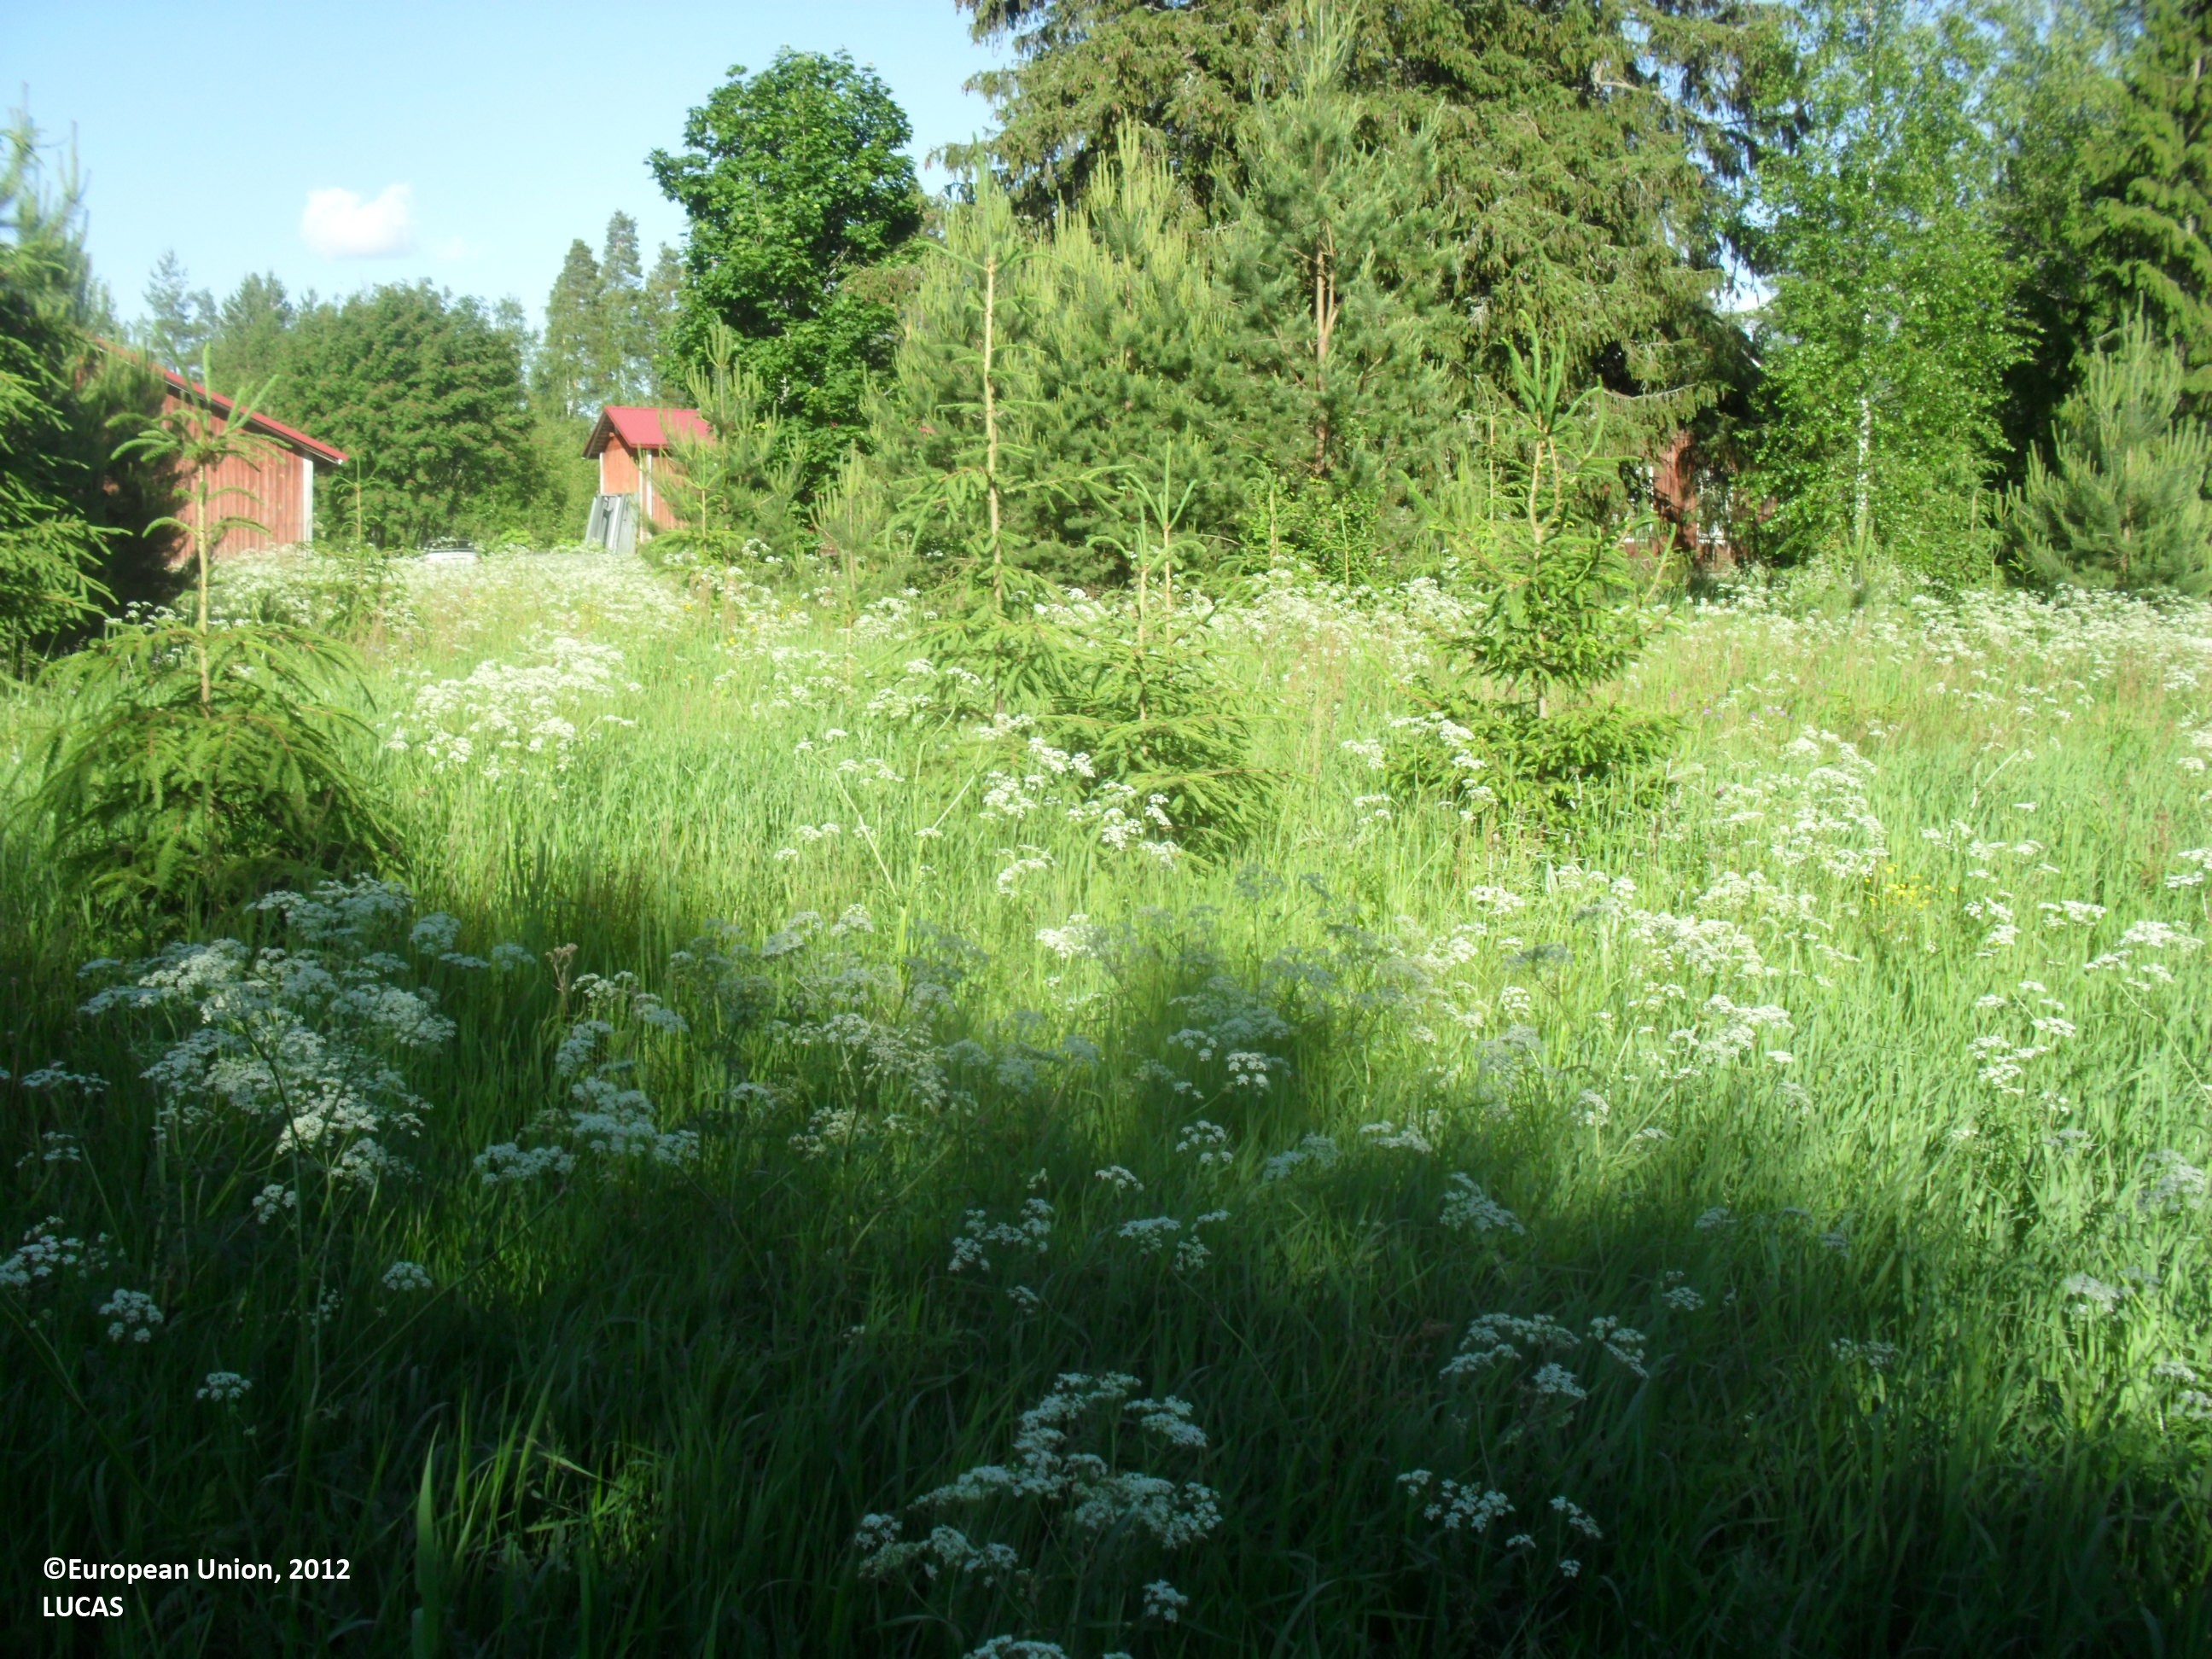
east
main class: Grassland
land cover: Spontaneously vegetated surfaces
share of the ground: > 75 %
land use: Abandoned areas
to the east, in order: Spontaneously vegetated surfaces; Grassland with sparse tree/shrub cover; Shrubland with sparse tree cover; Other mixed woodland; Barley; Tracks; Barley
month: June
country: FI
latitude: 62.9876
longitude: 23.7475
